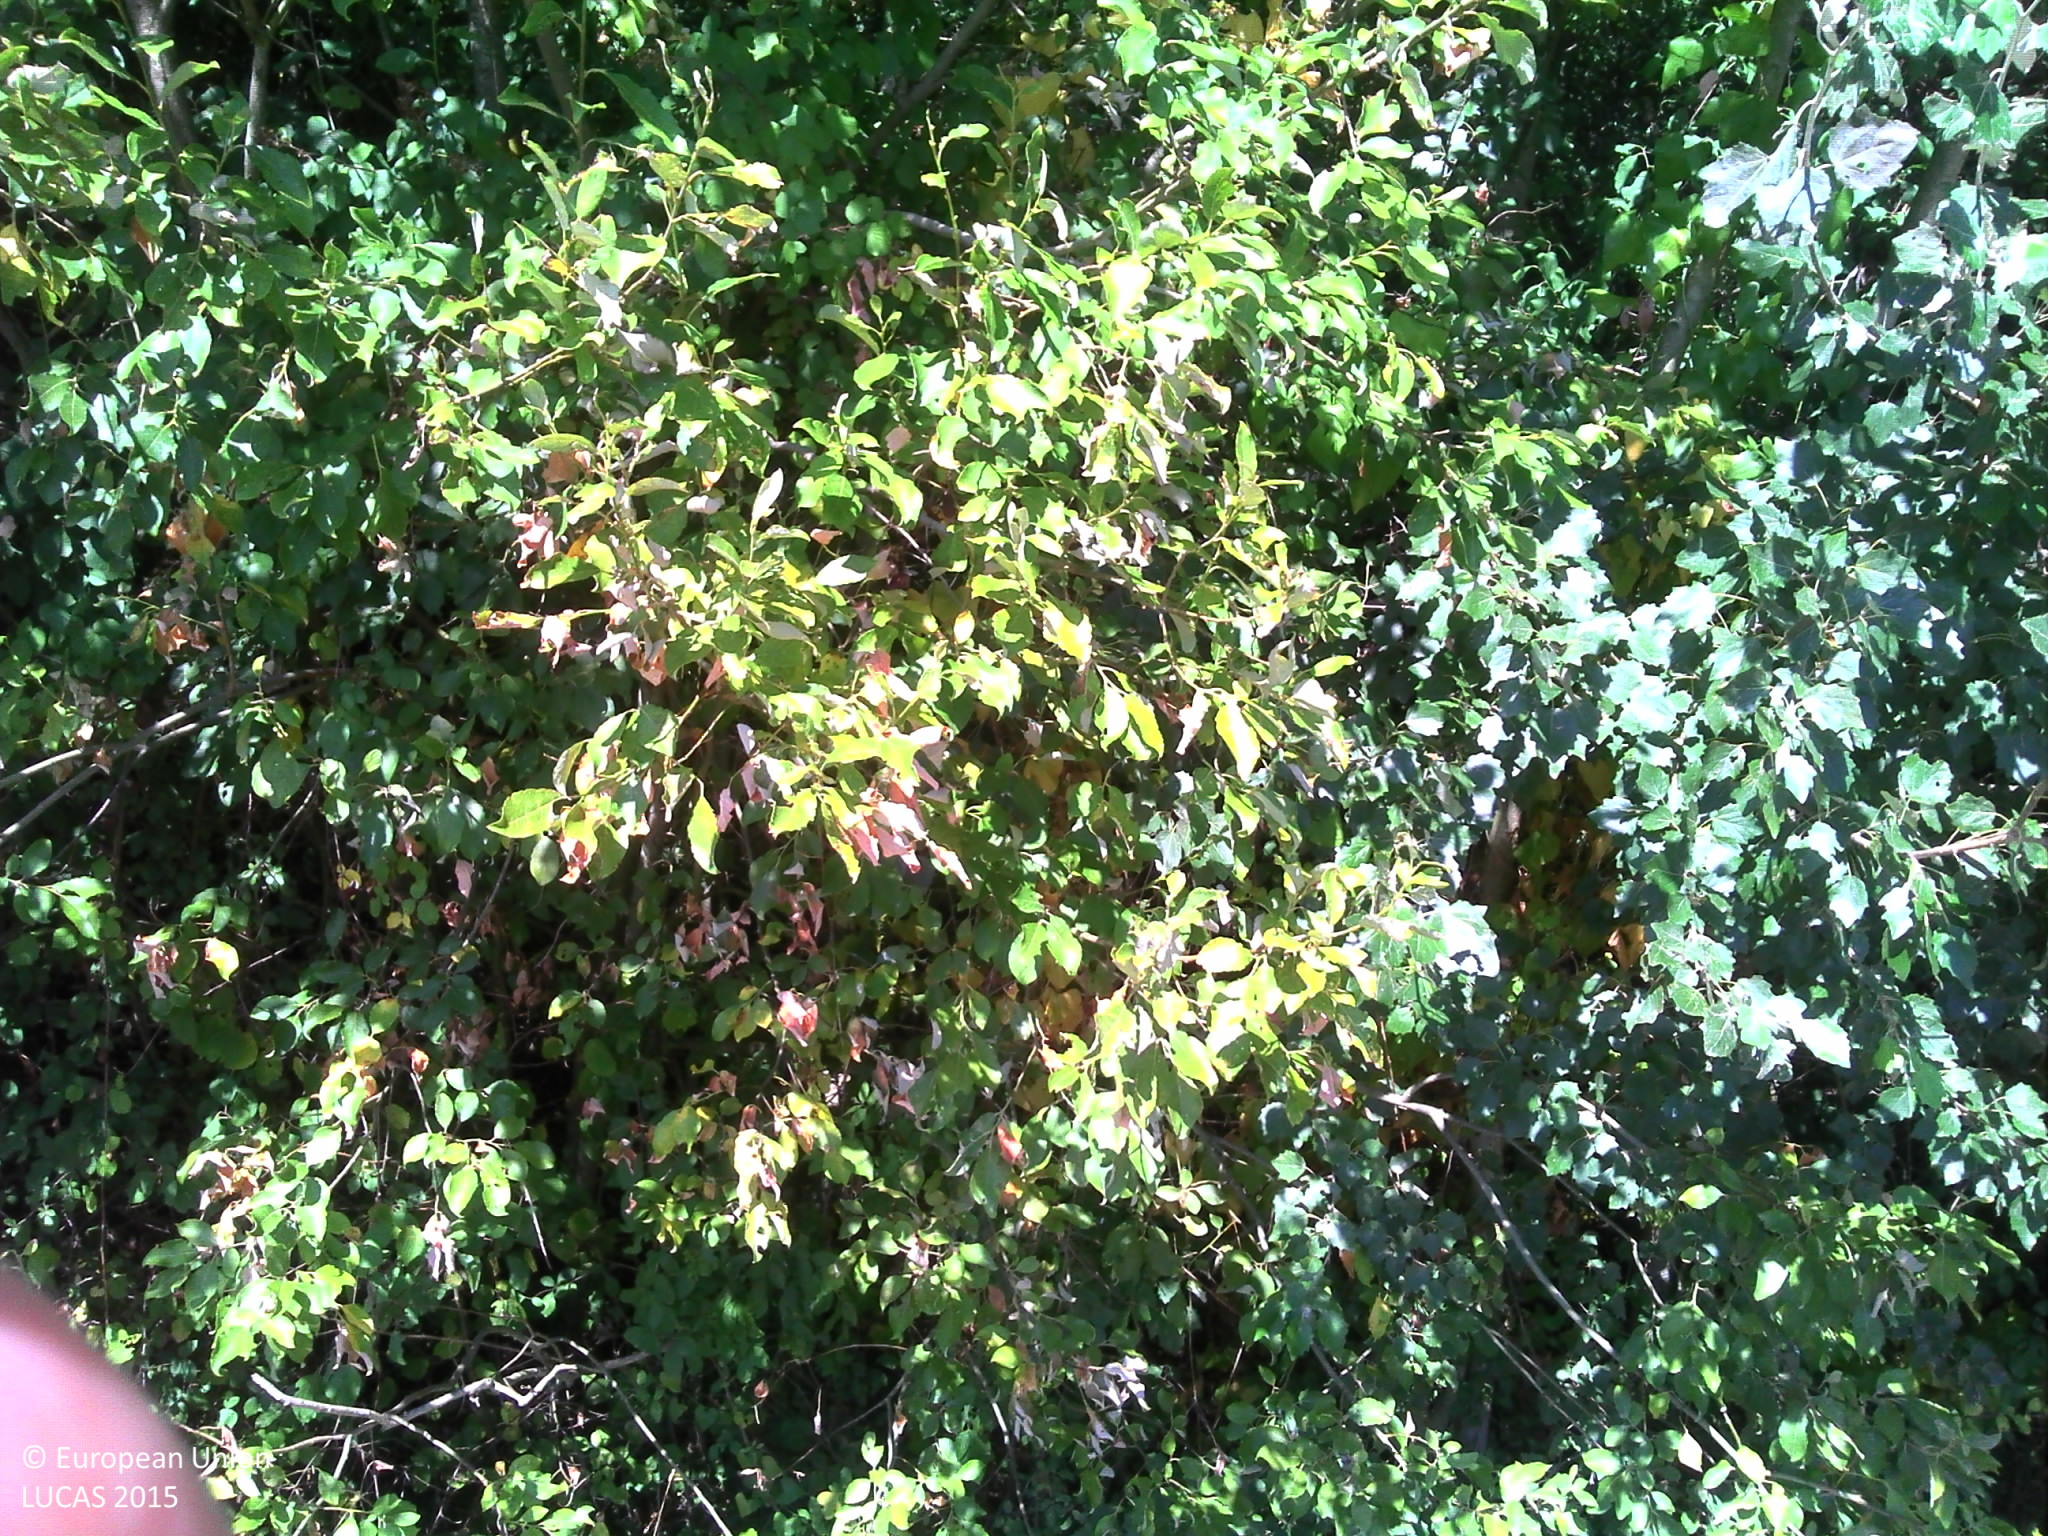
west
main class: Cropland
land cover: Sunflower
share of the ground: > 75 %
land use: Agriculture (excluding fallow land and kitchen gardens)
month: August
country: FR
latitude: 48.7249
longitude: 3.3183
